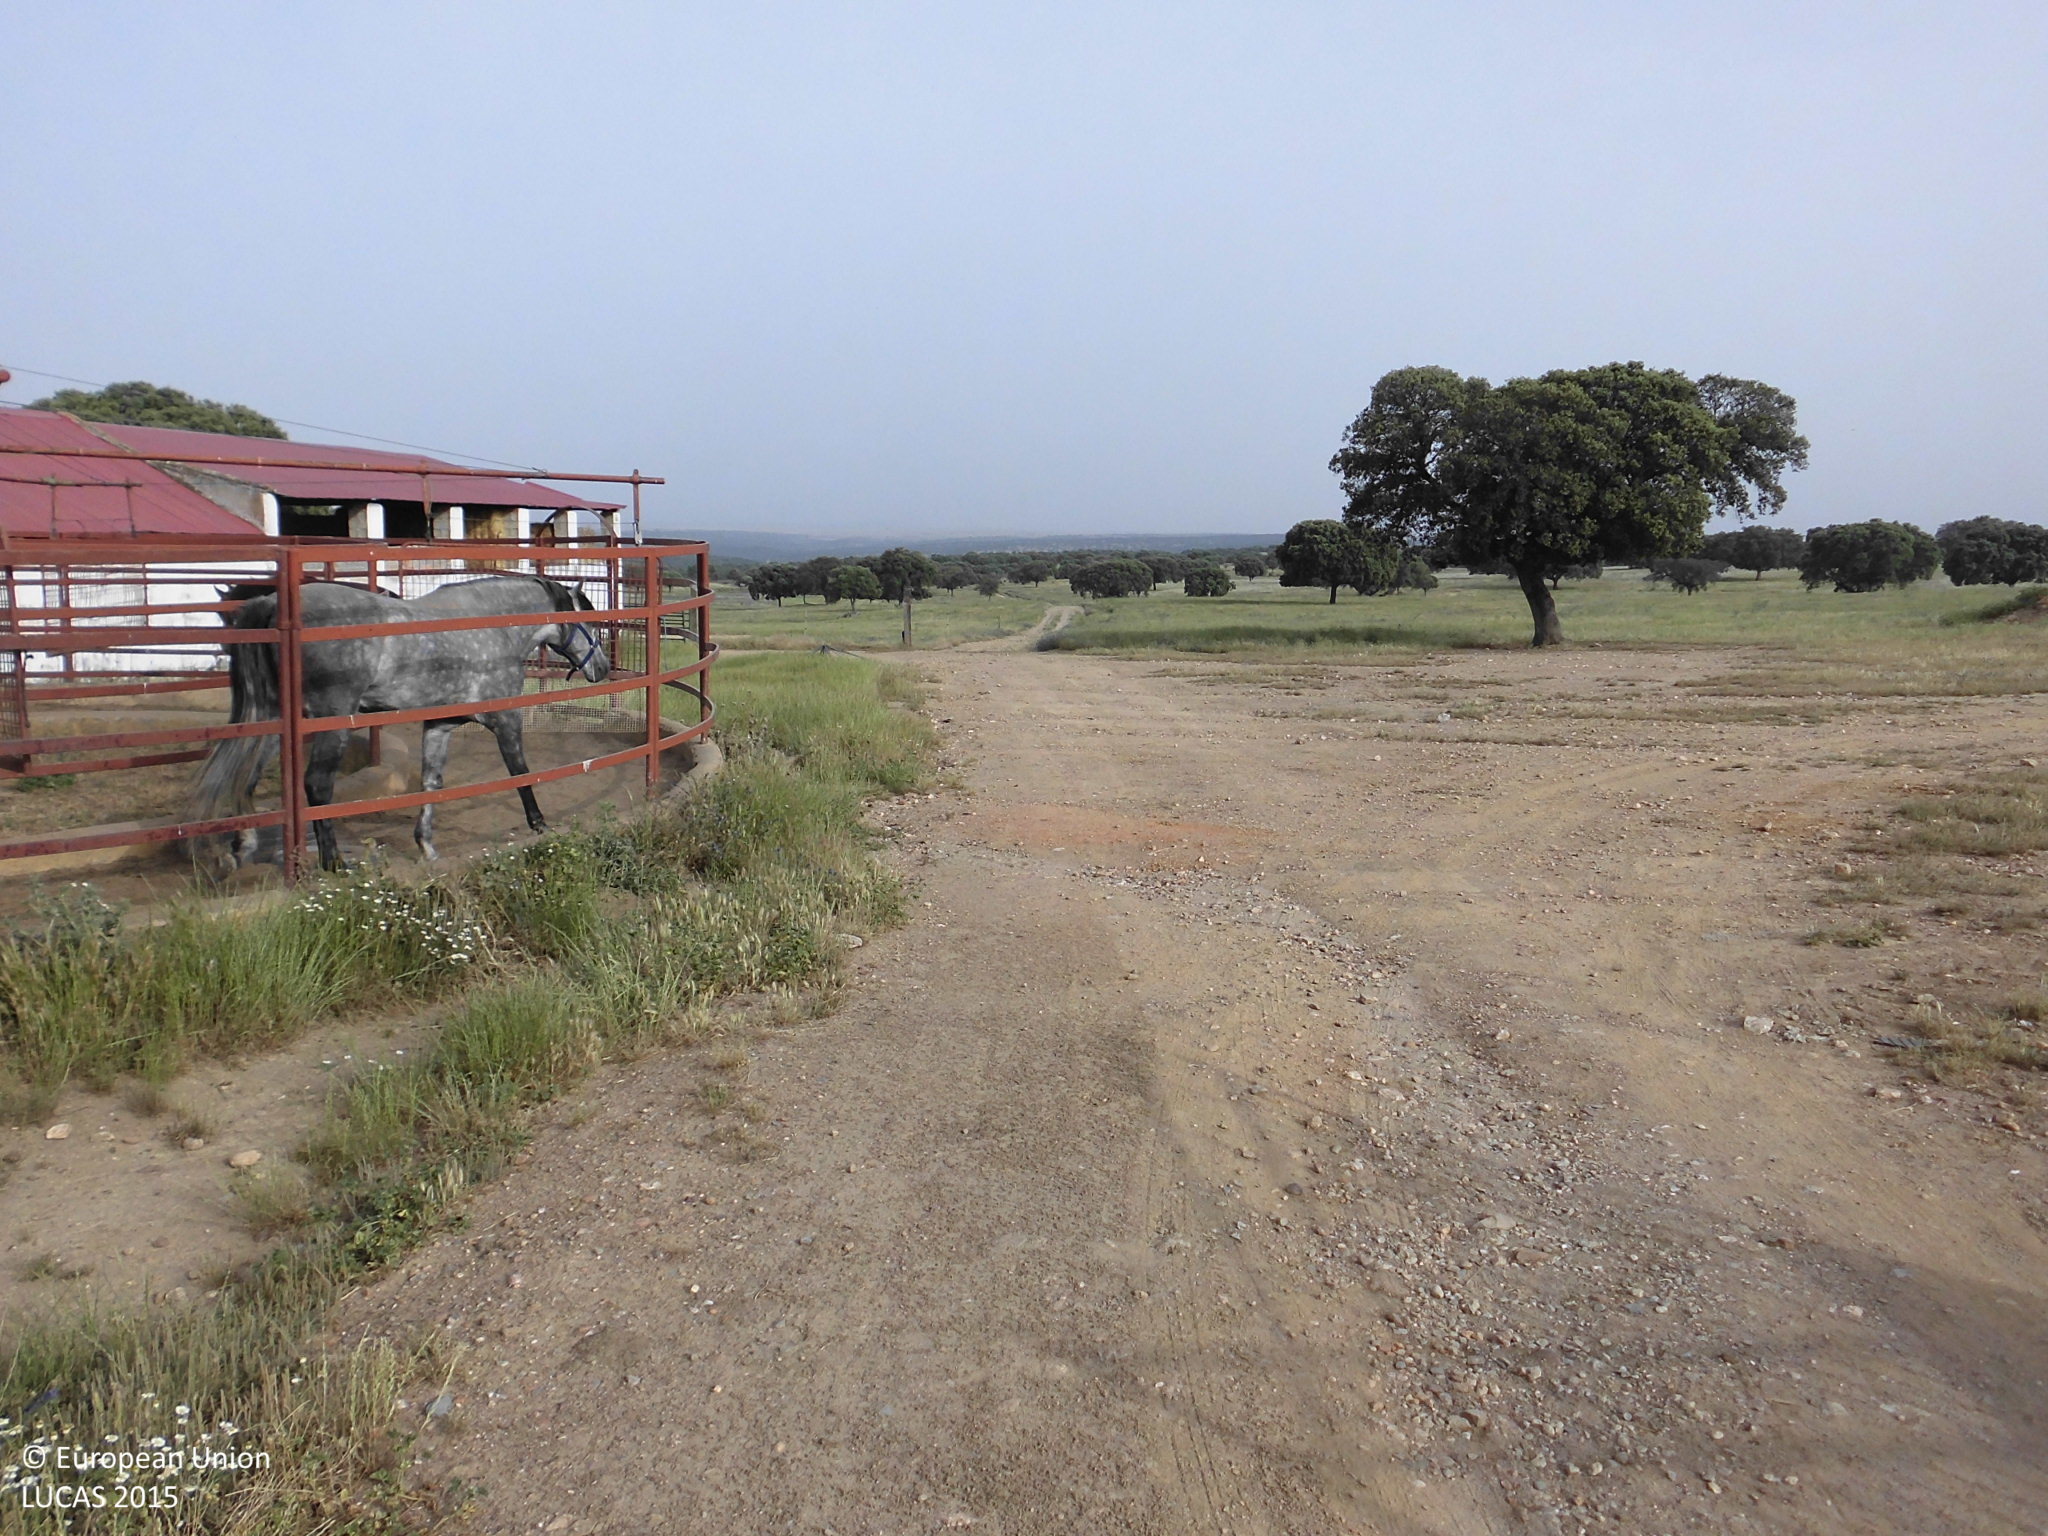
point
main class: Woodland
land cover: Broadleaved woodland
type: broadleaved evergreen forest
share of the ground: 10 - 25 %
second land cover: Grassland without tree/shrub cover
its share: > 75 %
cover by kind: shrubs 45 %, herbaceous plants 45 %, broadleaved forest trees 10 %
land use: Semi-natural and natural areas not in use
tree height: > 5 m
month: May
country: ES
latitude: 39.6046
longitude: -6.1256
